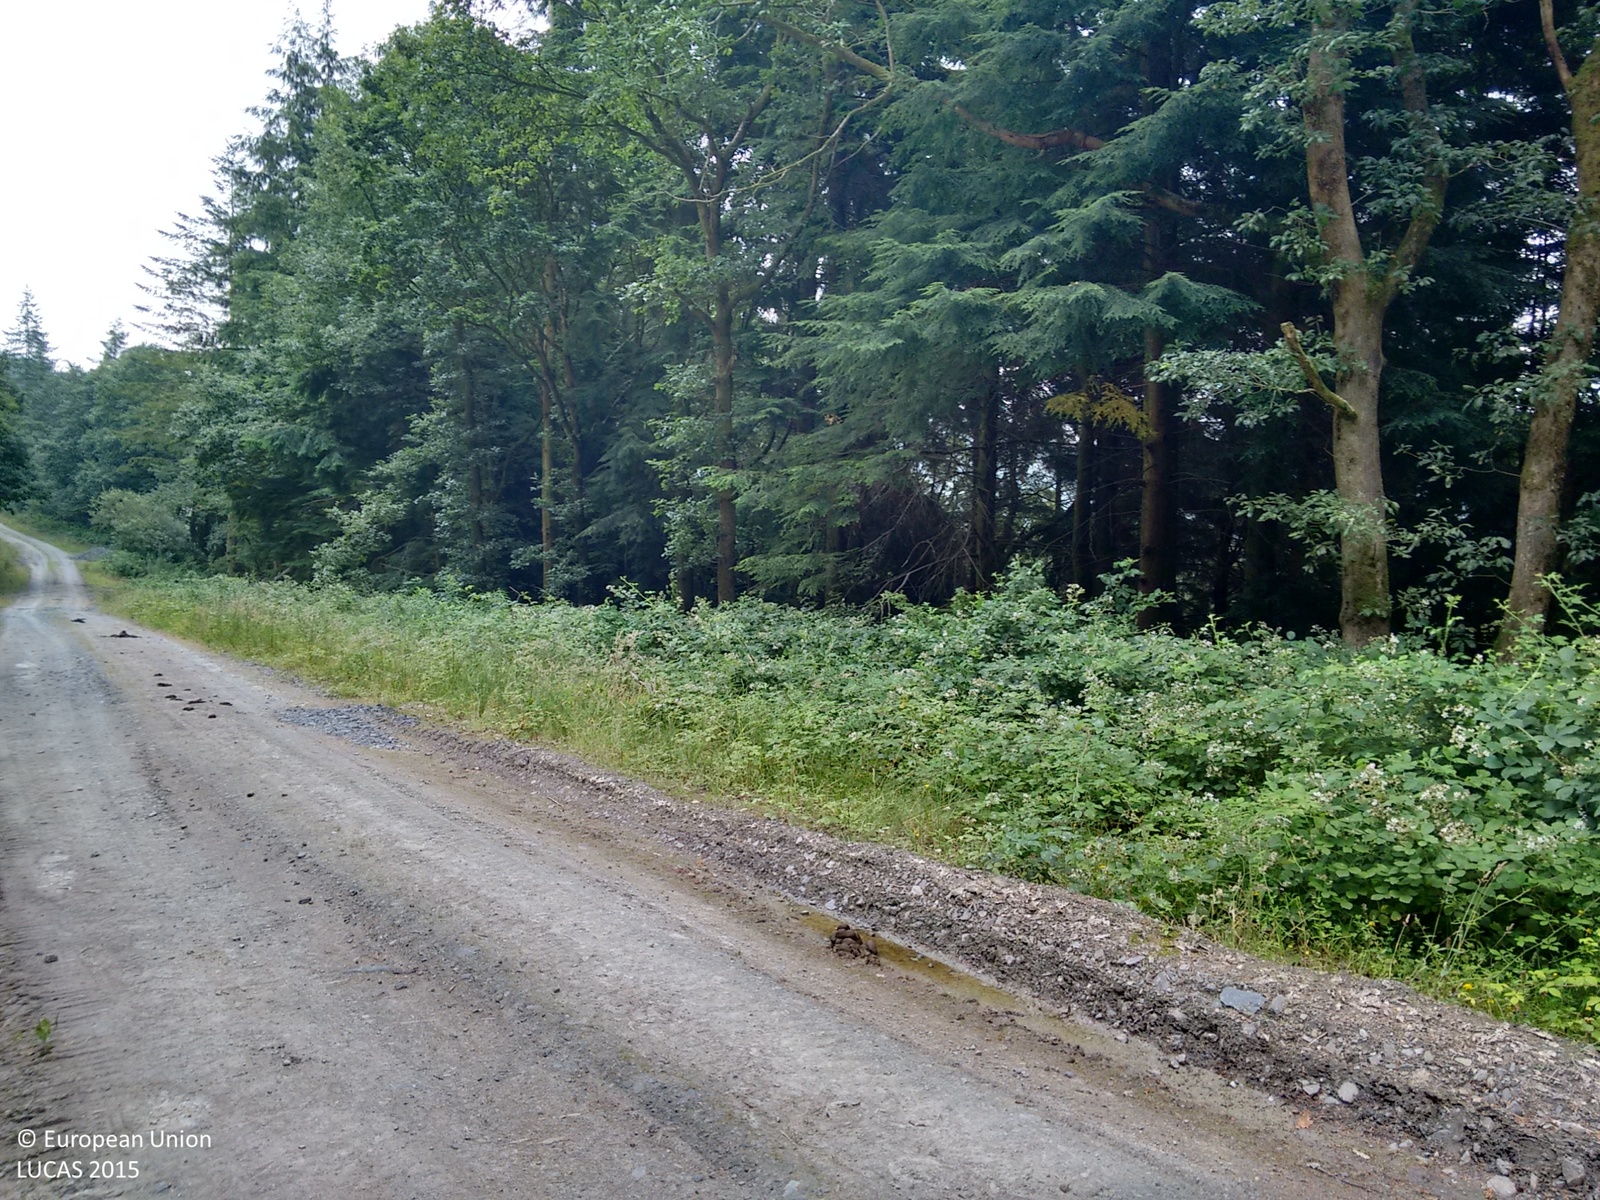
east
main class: Woodland
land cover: Spruce dominated coniferous woodland
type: exotic forest
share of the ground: > 75 %
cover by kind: coniferous forest trees 90 %, shrubs 10 %
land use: Forestry
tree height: > 5 m
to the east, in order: Spruce dominated coniferous woodland; Other bare soil; Grass margins; Tracks; Shruby margins; Spruce dominated coniferous woodland; Broadleaved woodland; Rivers and streams; Shrubland without tree cover; Tracks; Broadleaved woodland
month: August
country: GB
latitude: 52.0789
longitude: -3.9407
